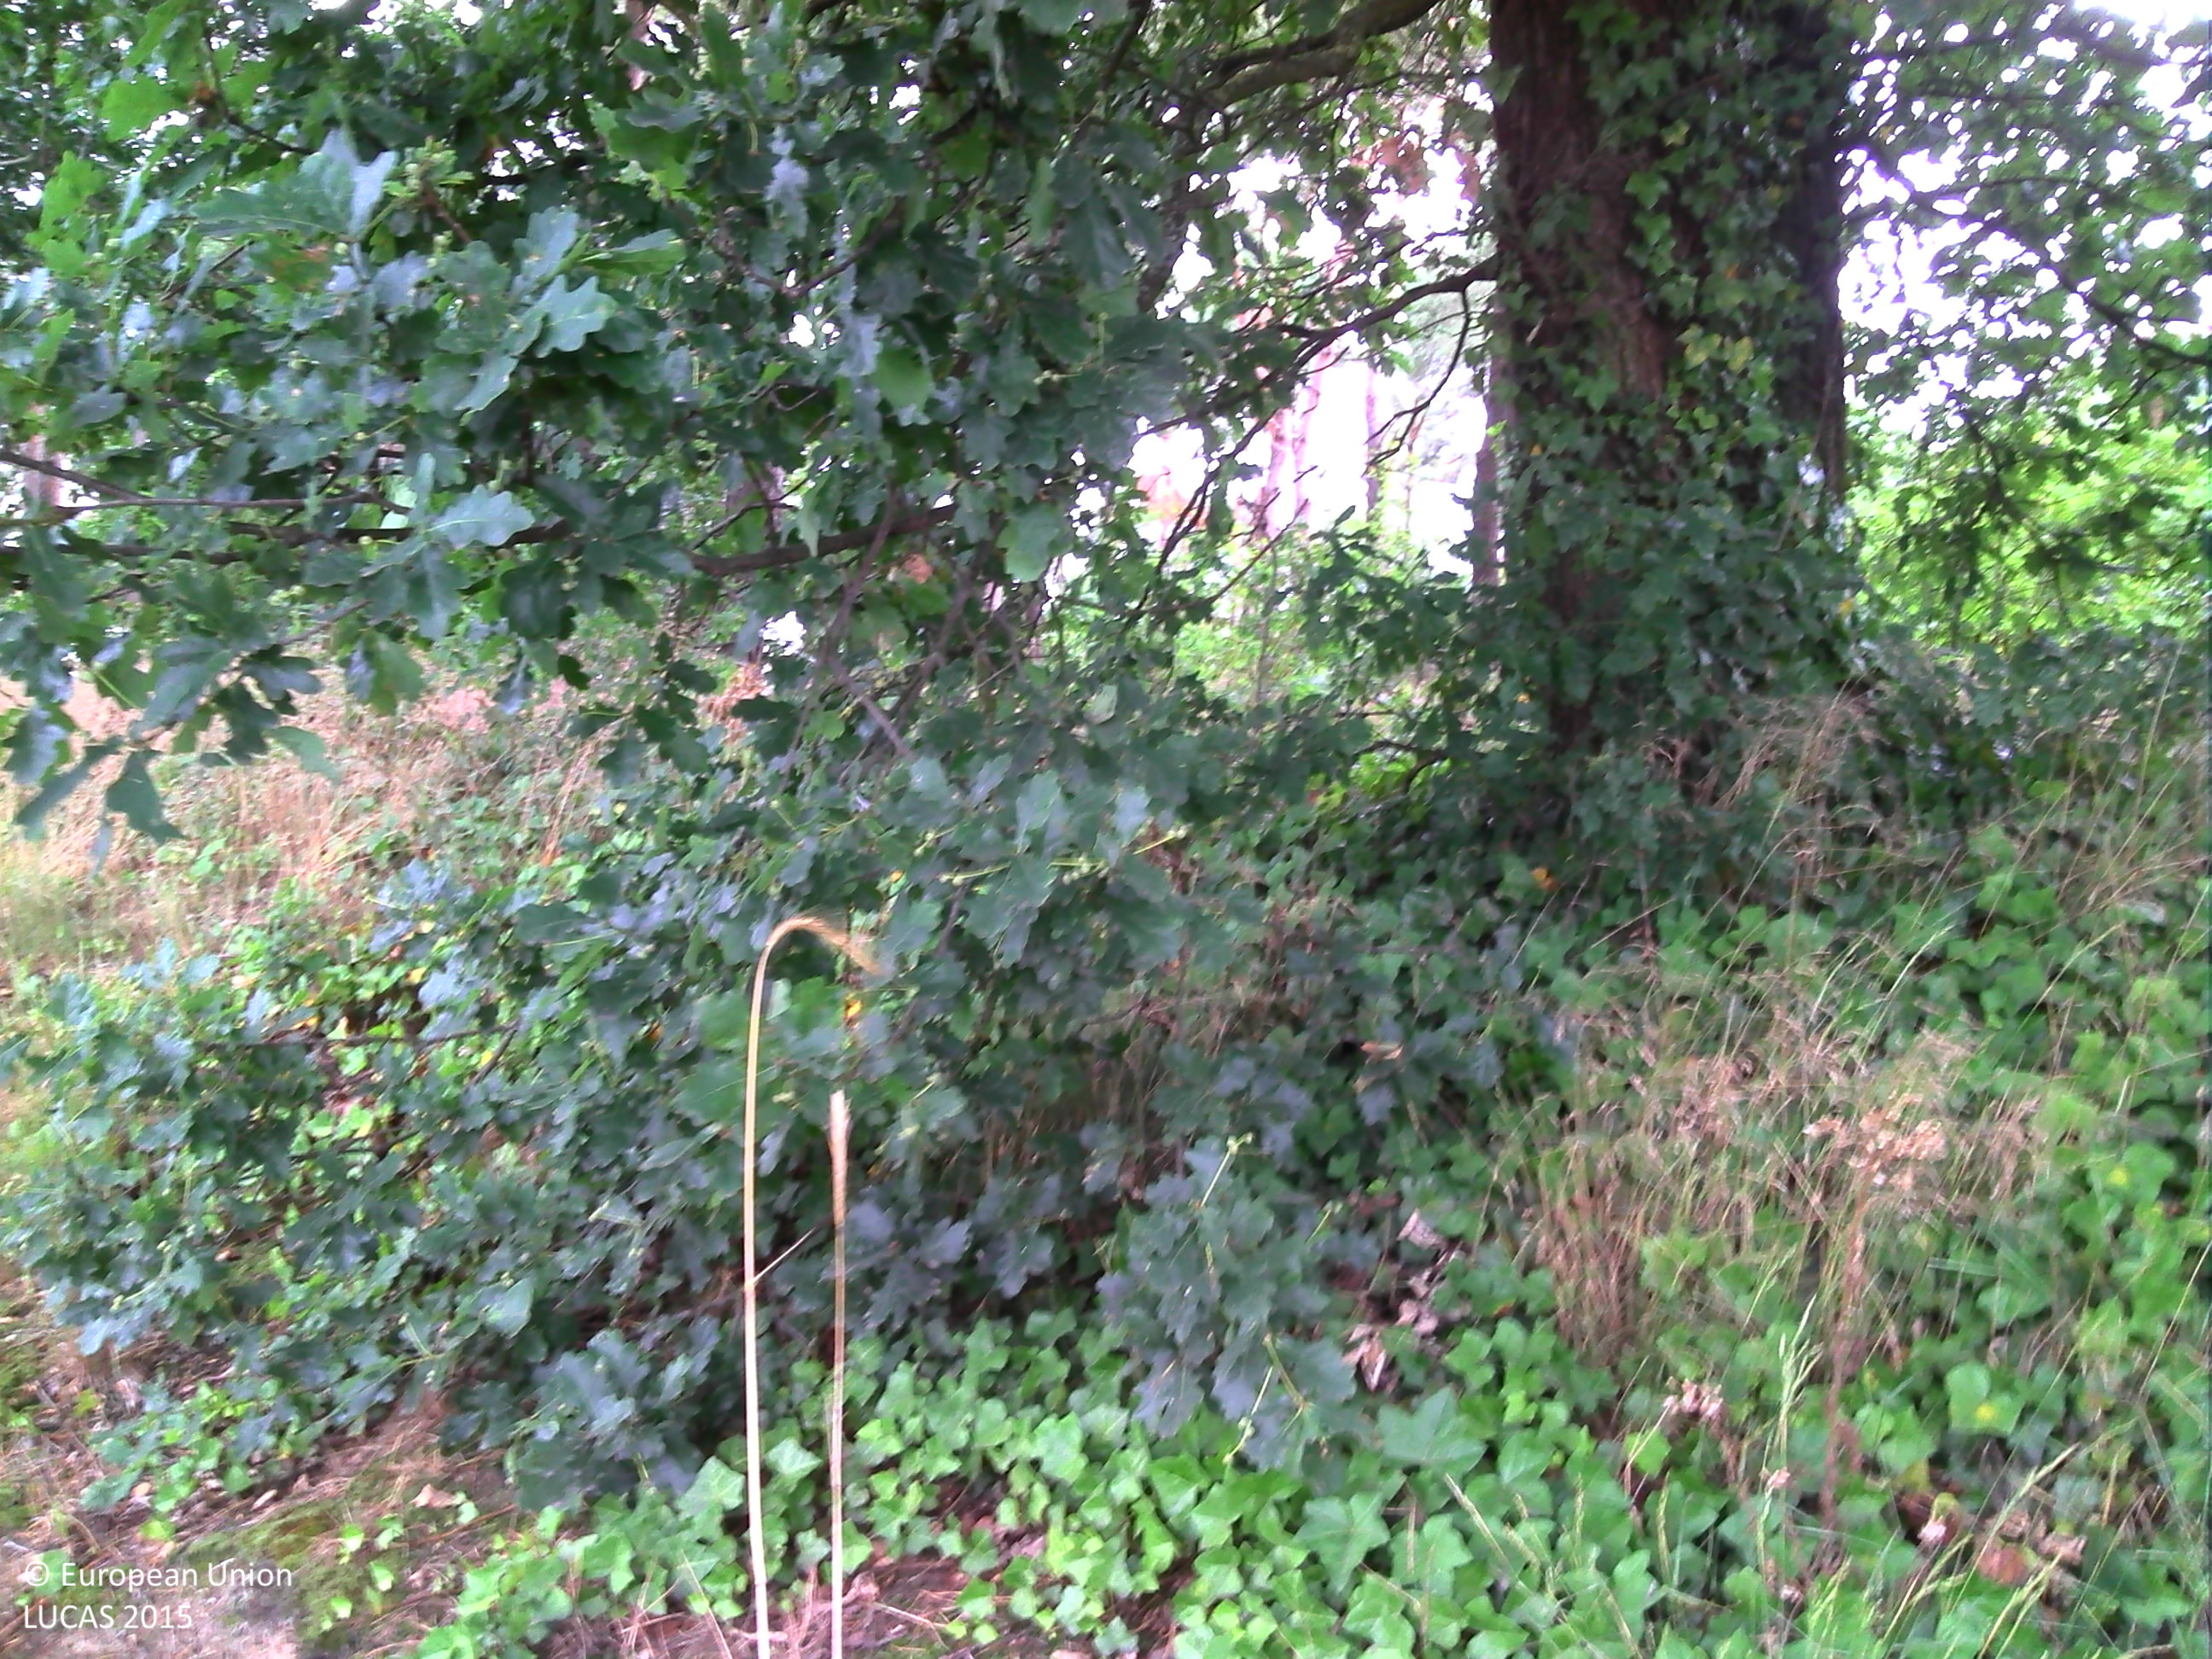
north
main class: Cropland
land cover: Potatoes
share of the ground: > 75 %
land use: Agriculture (excluding fallow land and kitchen gardens)
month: July
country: BE
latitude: 51.2104
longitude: 5.4603
